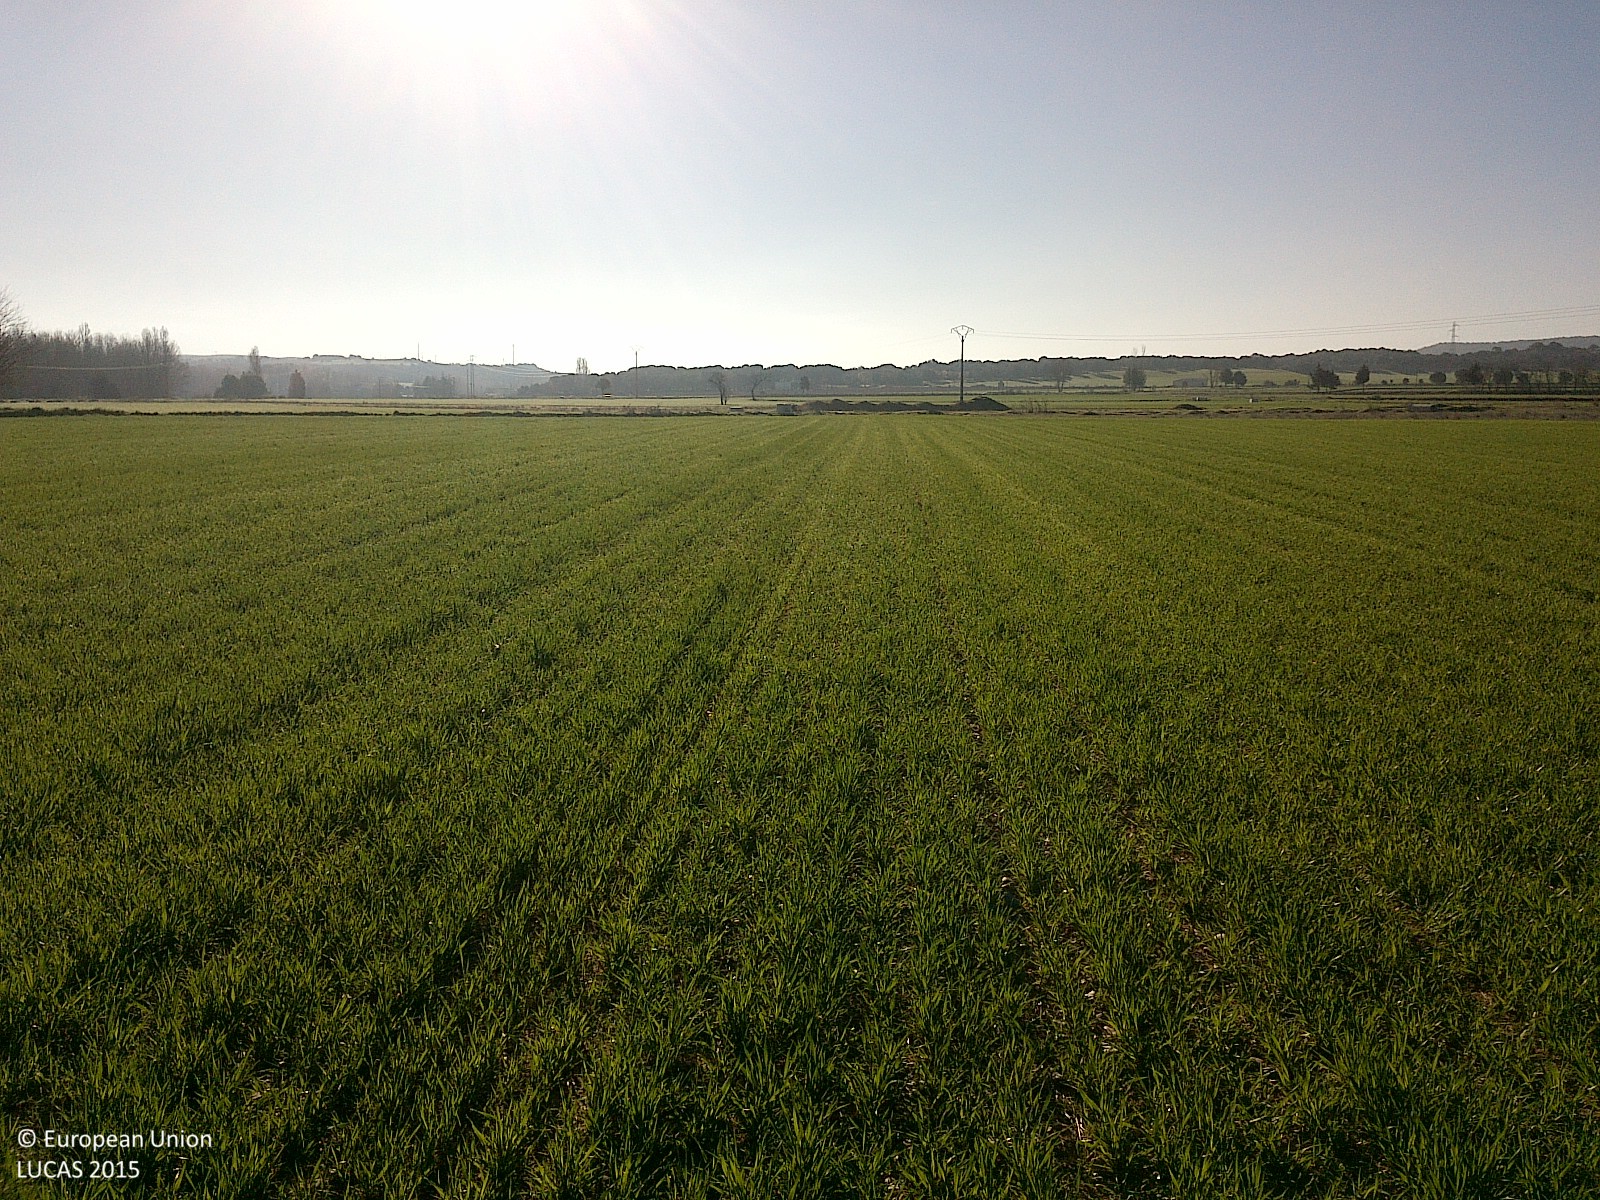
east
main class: Cropland
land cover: Common wheat
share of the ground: > 75 %
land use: Agriculture (excluding fallow land and kitchen gardens)
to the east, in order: Common wheat; Single bushes/trees; Common wheat; Spontaneously vegetated surfaces
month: April
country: ES
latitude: 41.6349
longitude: -3.5067
